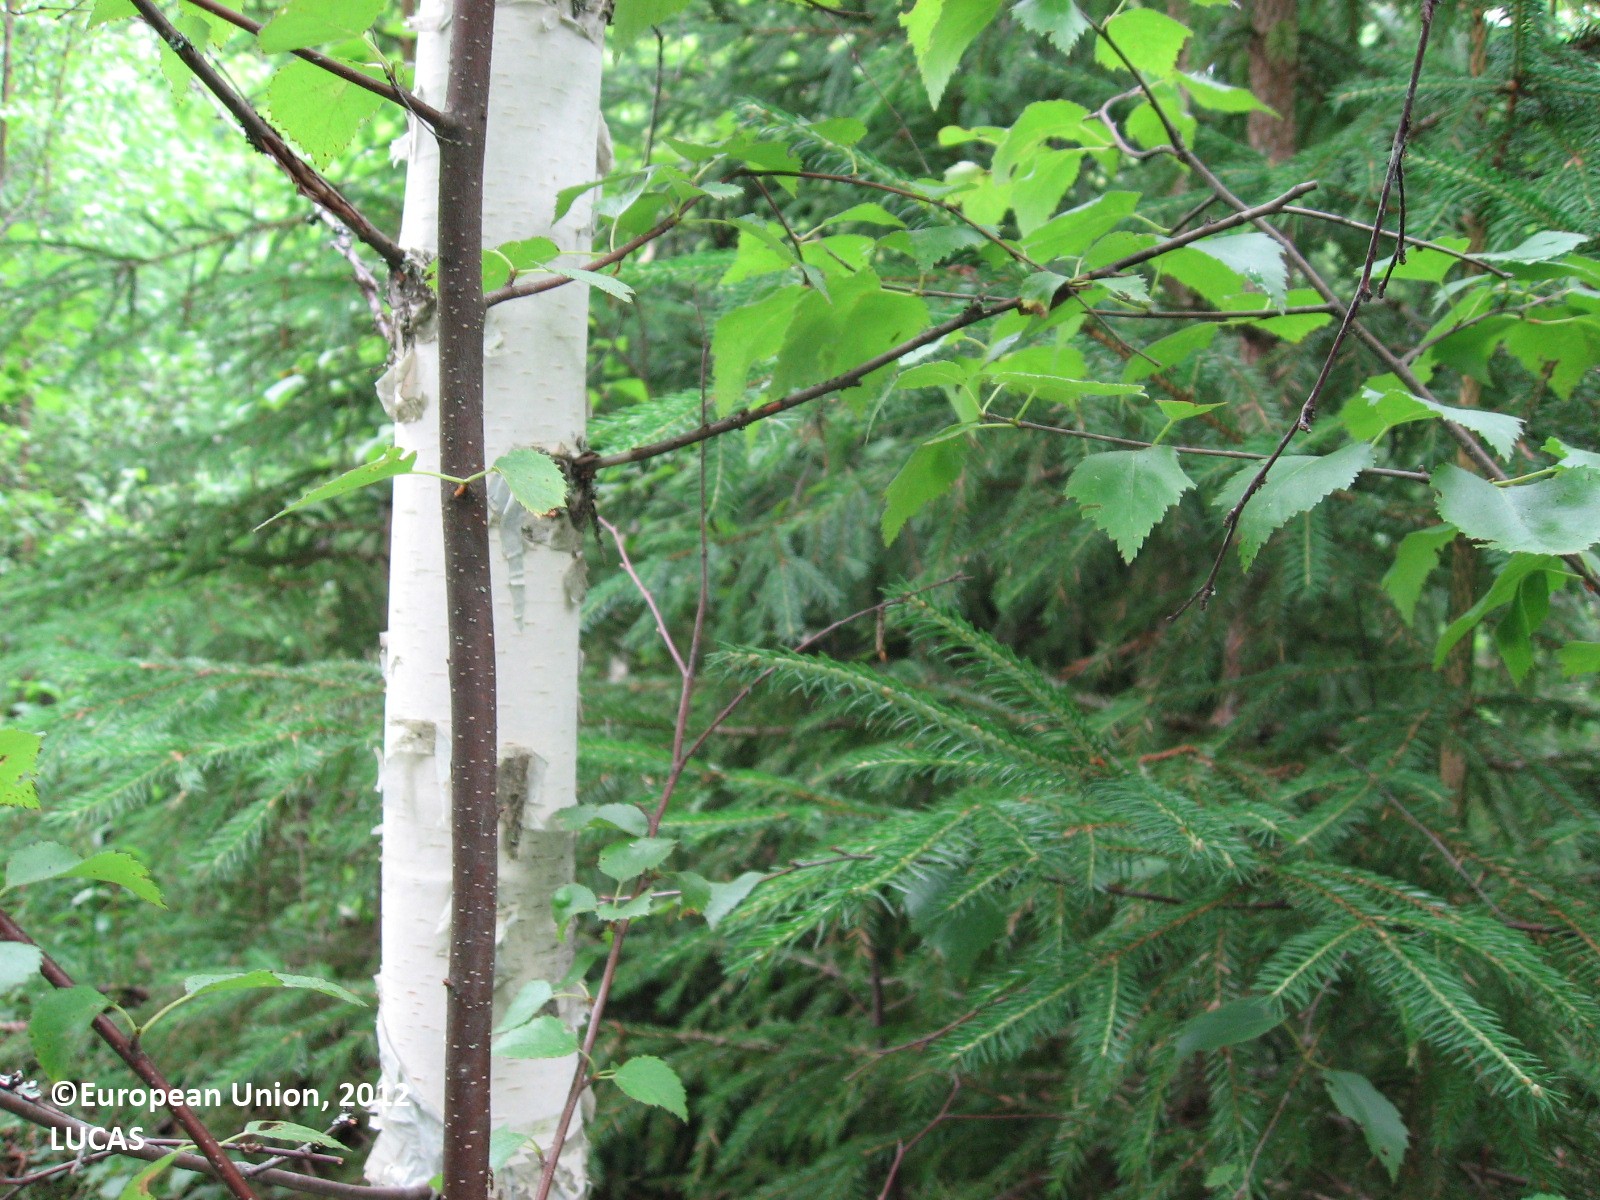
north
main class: Woodland
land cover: Spruce dominated mixed woodland
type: boreal forest
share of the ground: > 75 %
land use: Forestry
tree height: > 5 m
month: July
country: FI
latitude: 60.8465
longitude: 25.6432
